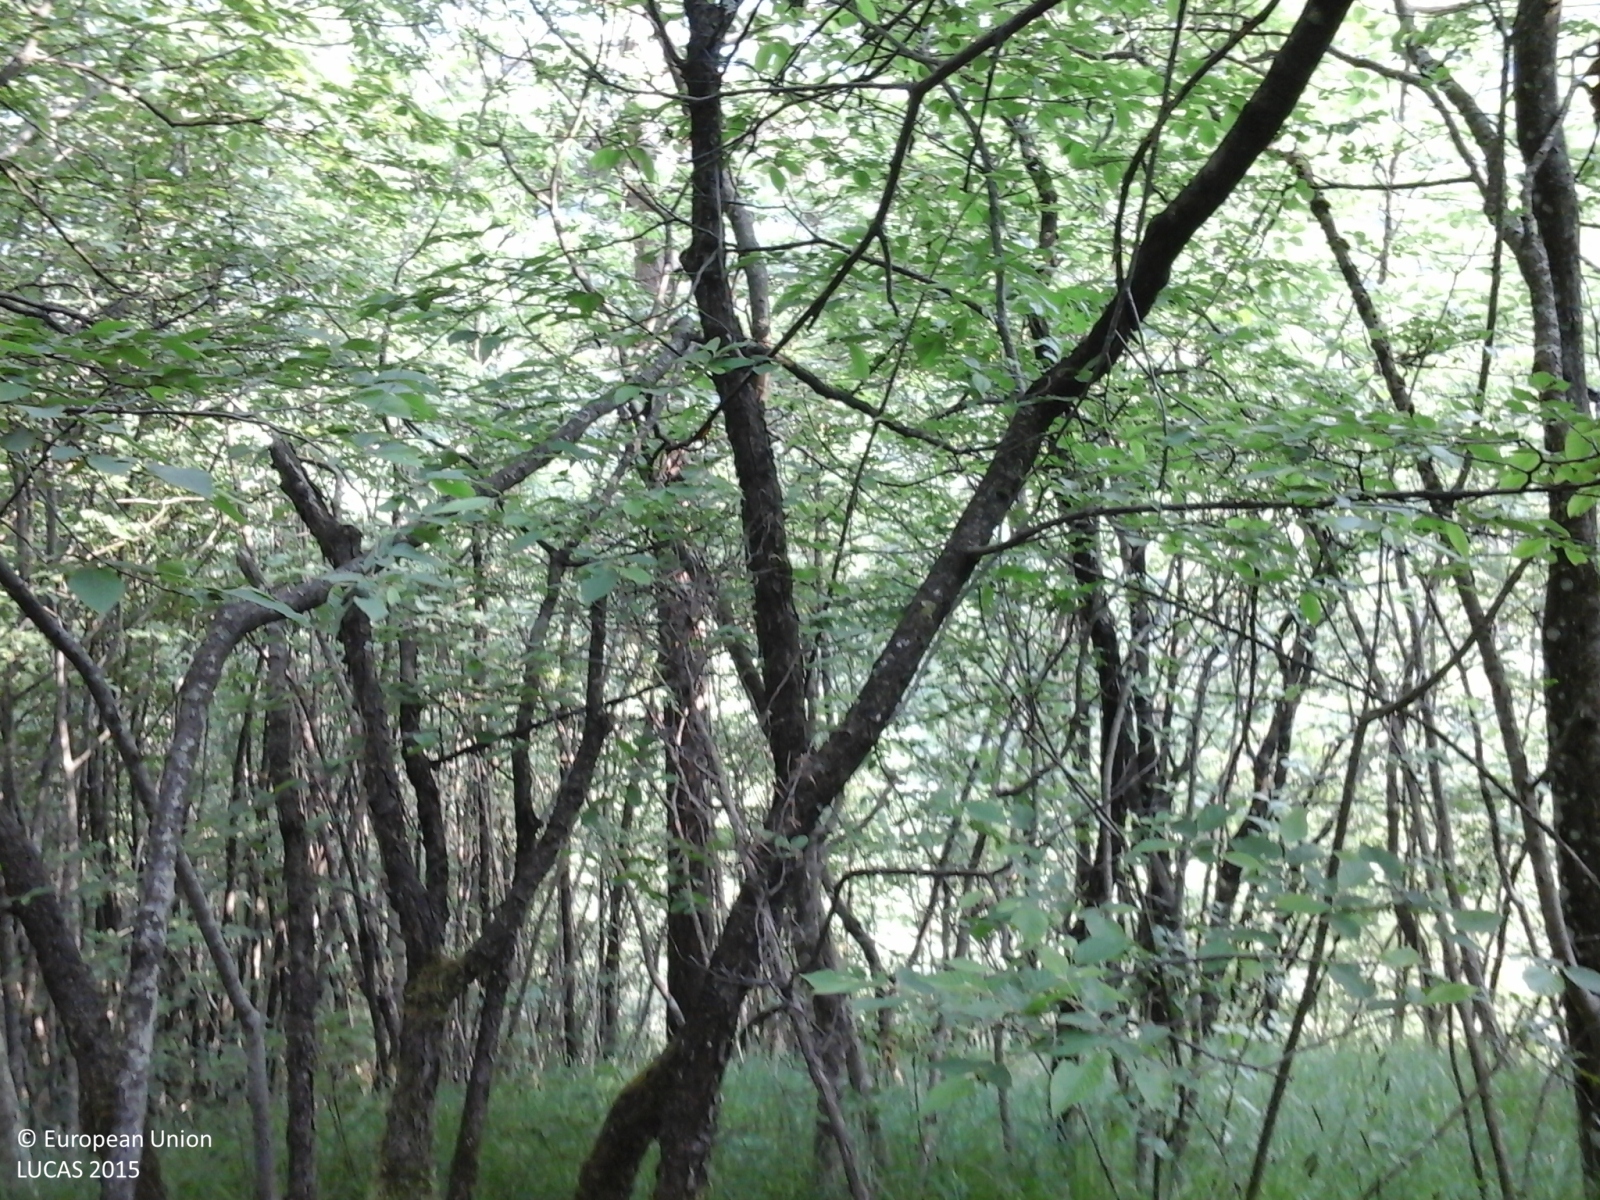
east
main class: Woodland
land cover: Broadleaved woodland
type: thermophilous deciduous forest
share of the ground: > 75 %
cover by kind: broadleaved forest trees 100 %
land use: Semi-natural and natural areas not in use
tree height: > 5 m
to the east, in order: Broadleaved woodland
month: June
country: IT
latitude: 46.1808
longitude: 12.3678
